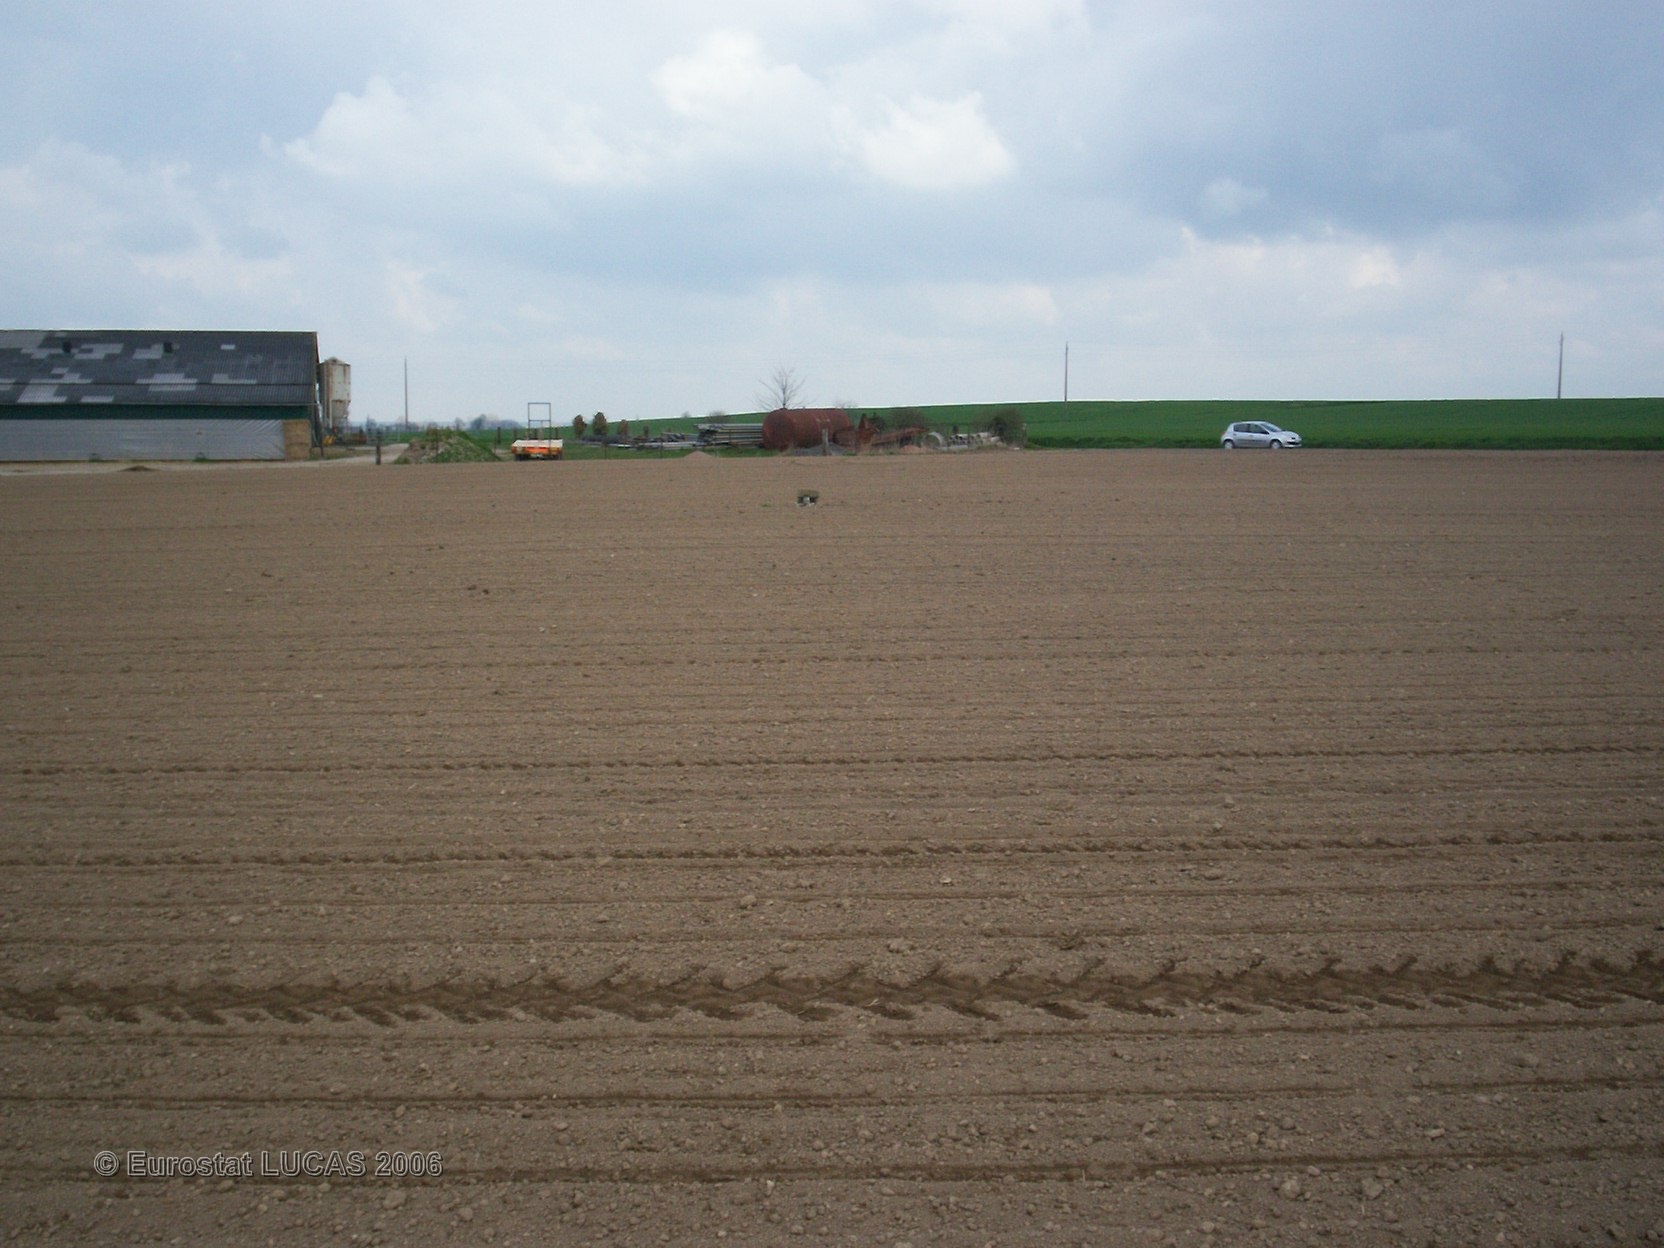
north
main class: Cropland
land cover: Sugar beet
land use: Agriculture (excluding fallow land and kitchen gardens)
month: May
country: FR
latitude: 48.9223
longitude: -0.0622
